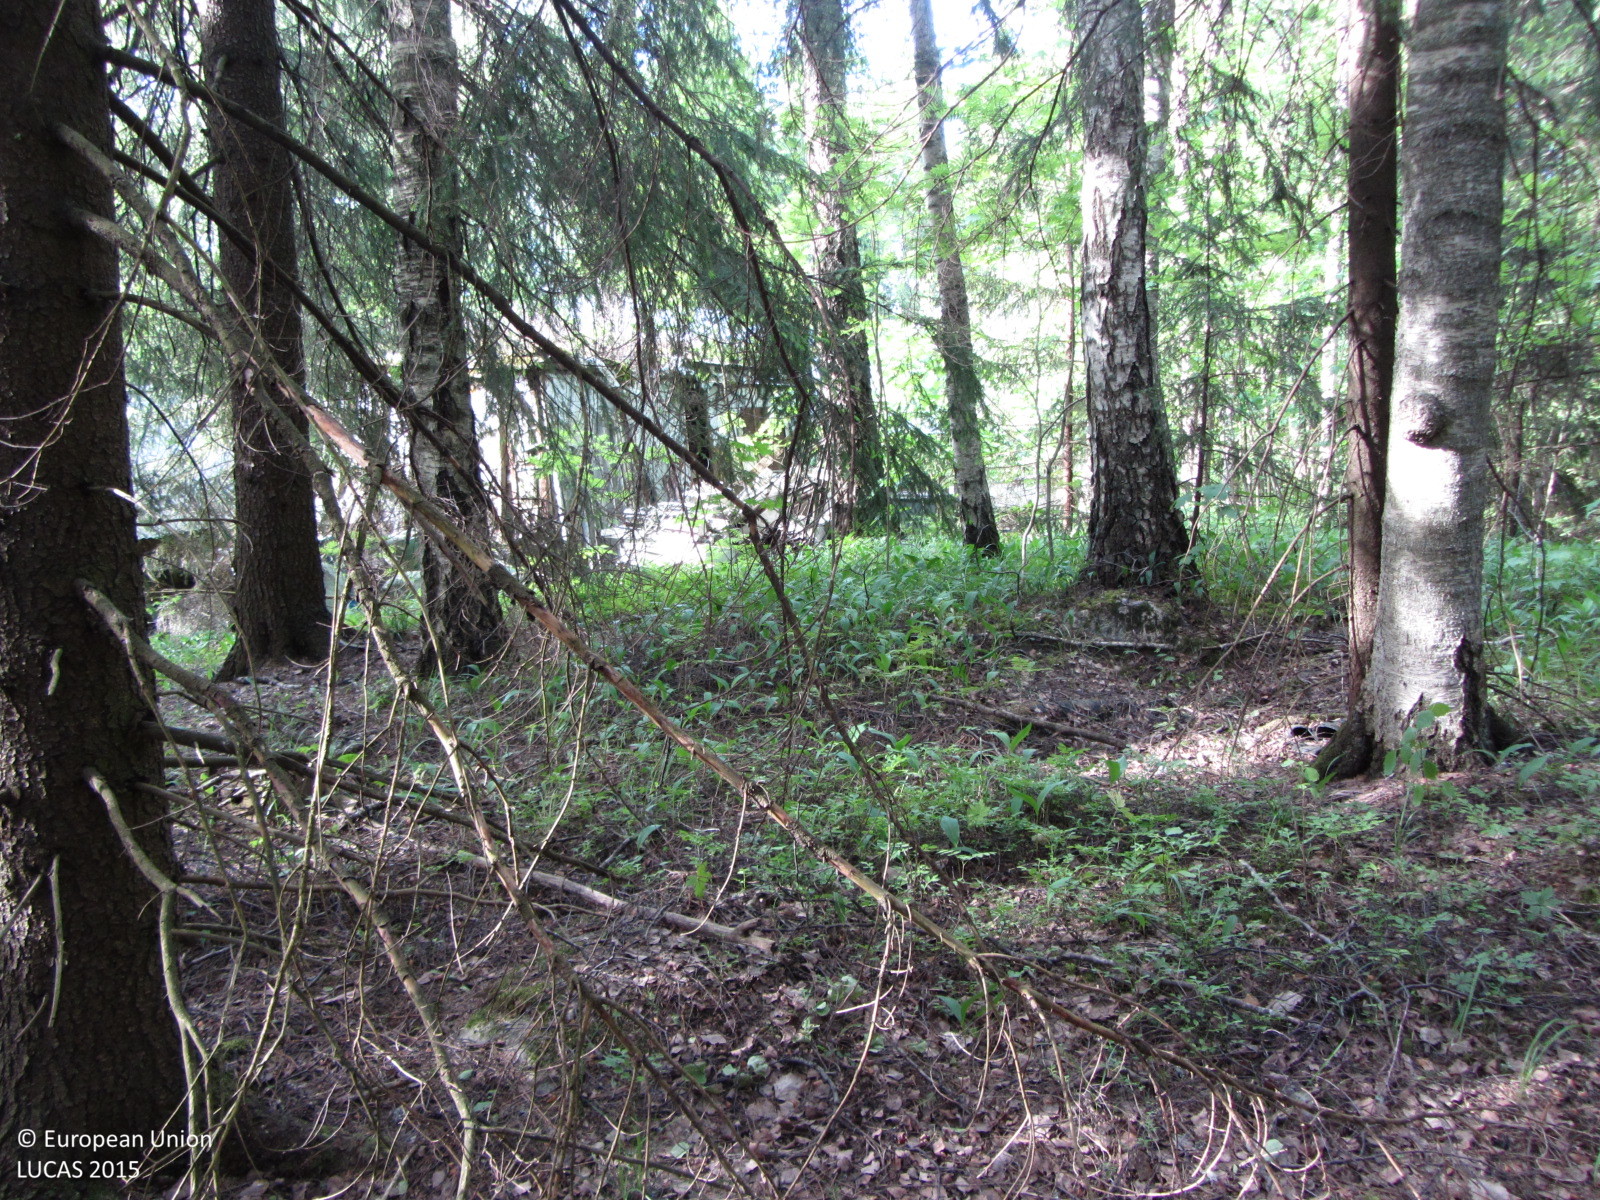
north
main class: Woodland
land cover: Spruce dominated mixed woodland
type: boreal forest
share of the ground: 50 - 75 %
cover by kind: coniferous forest trees 40 %, broadleaved forest trees 20 %, herbaceous plants 20 %, unconsolidated bare surface 20 %
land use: Residential
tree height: > 5 m
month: June
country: FI
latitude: 60.3149
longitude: 24.2402
